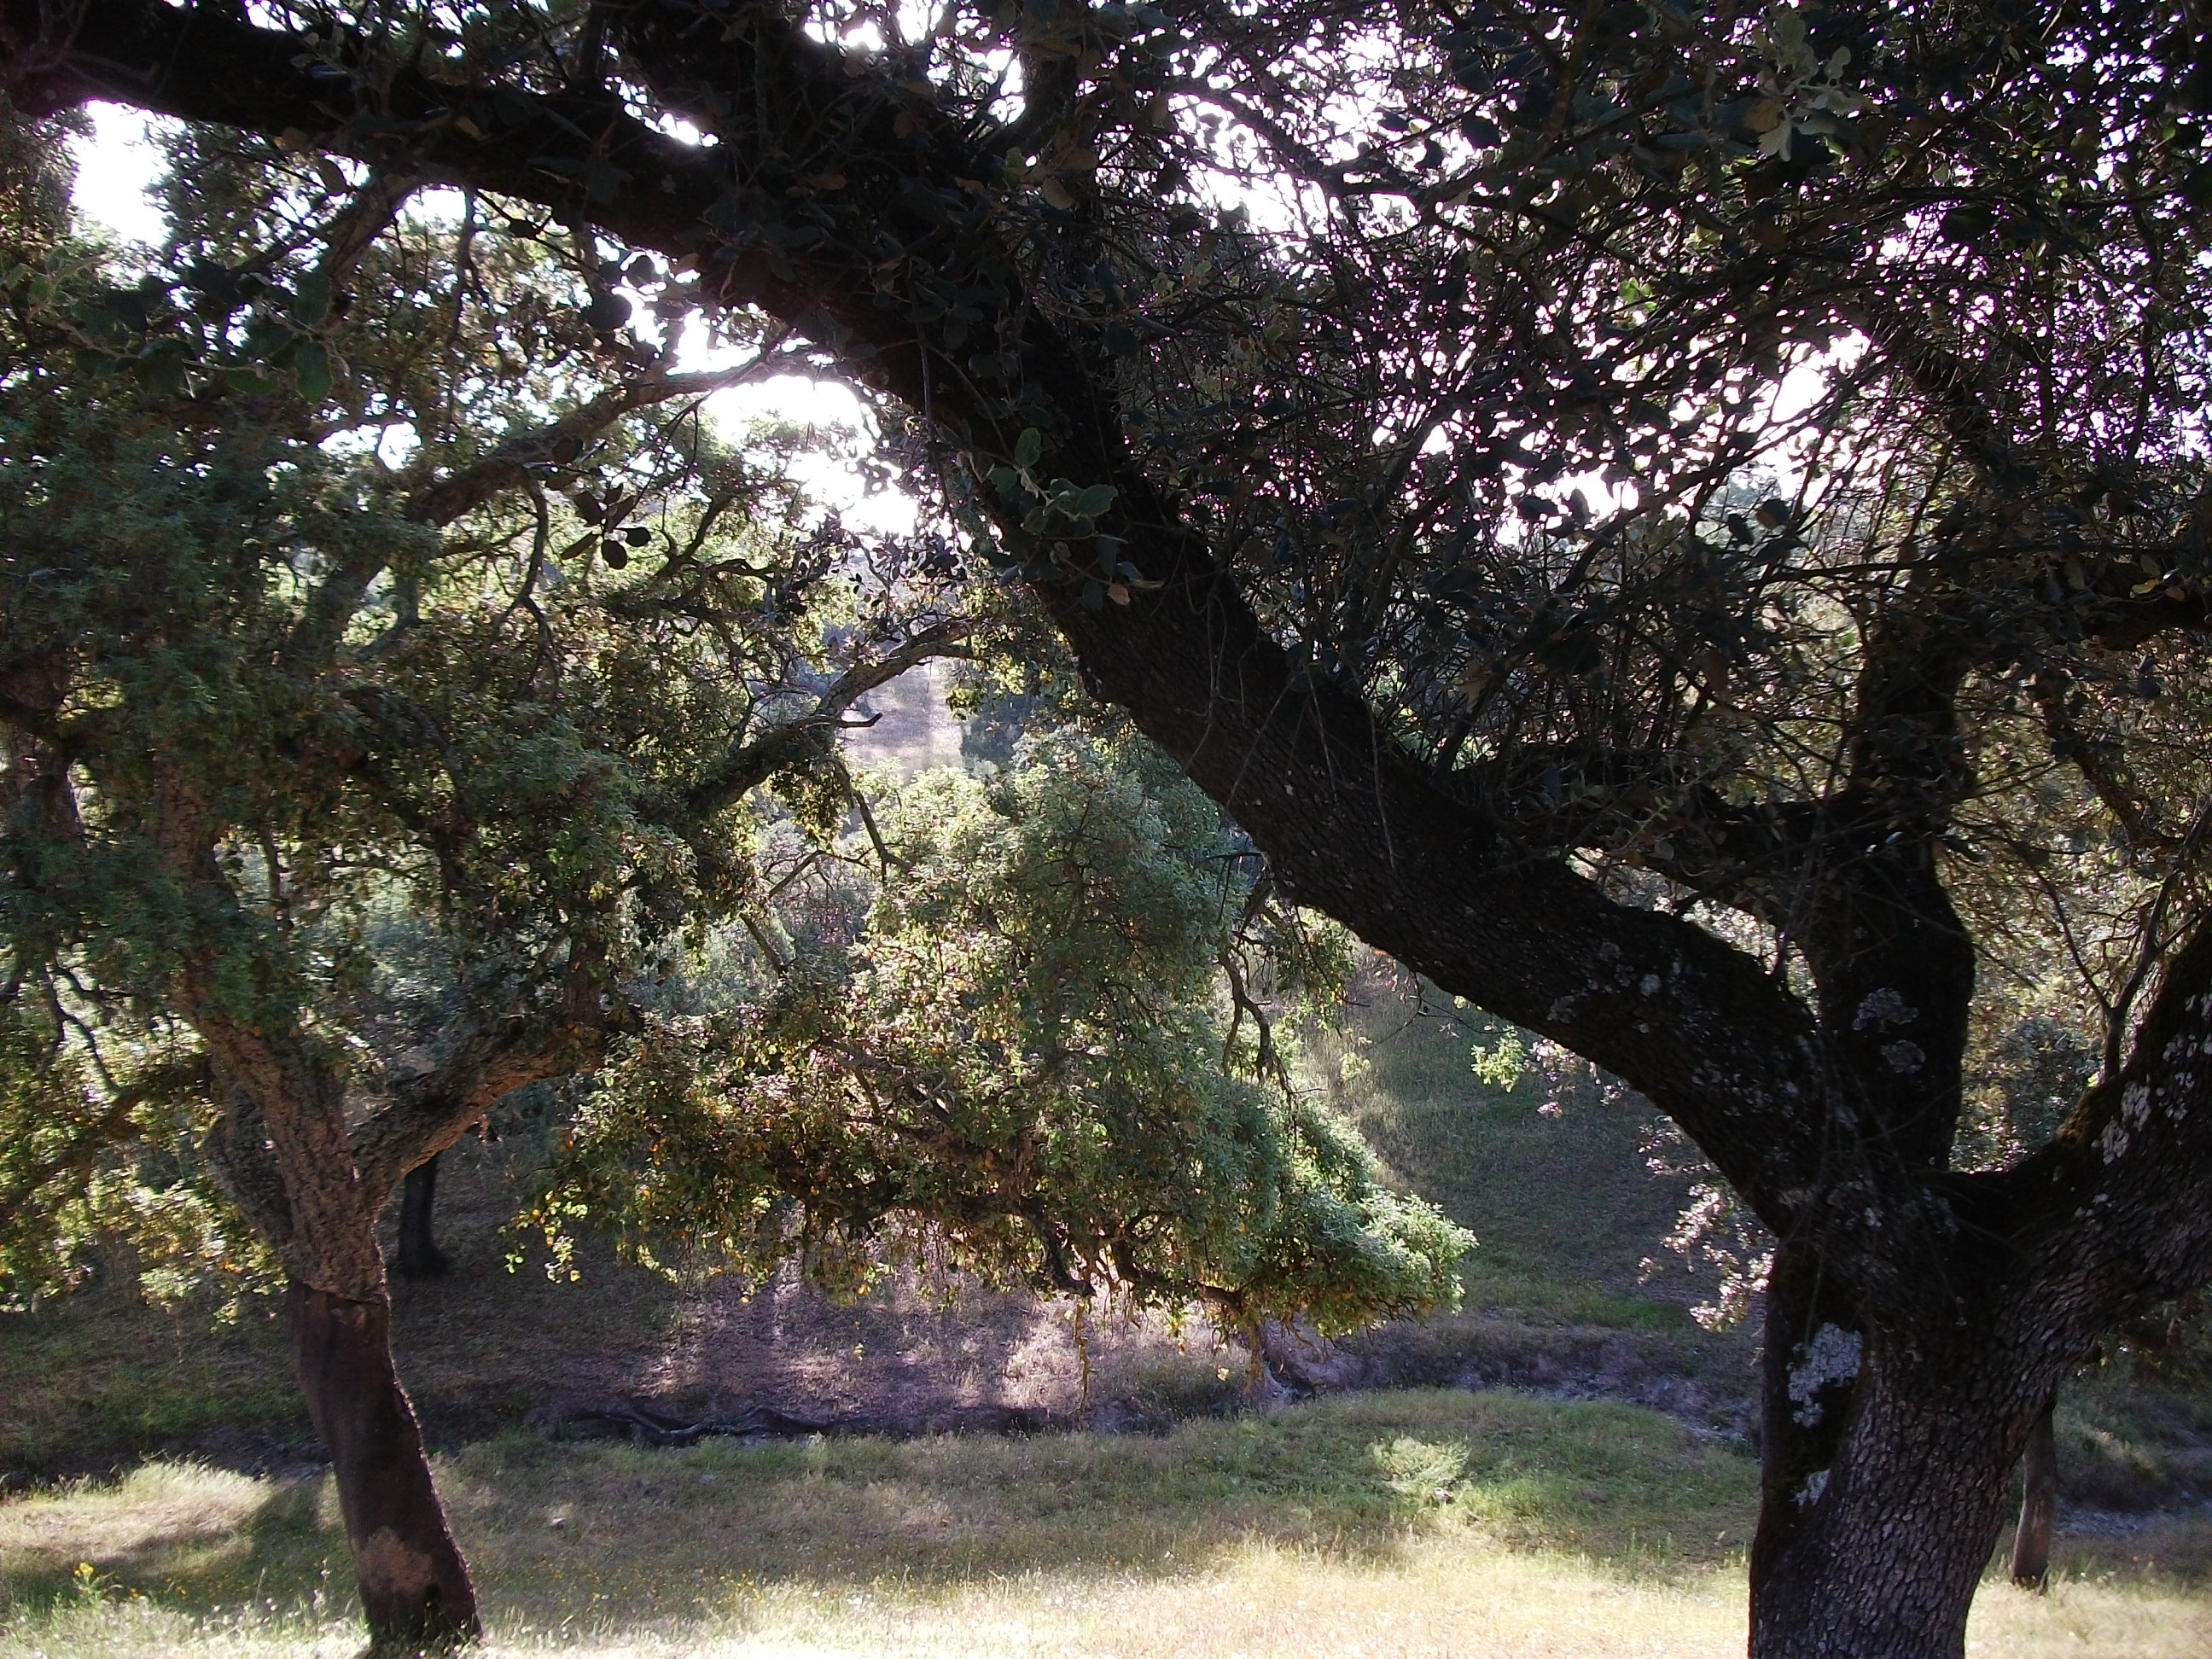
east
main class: Woodland
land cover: Broadleaved woodland
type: broadleaved evergreen forest
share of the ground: 25 - 50 %
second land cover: Spontaneously vegetated surfaces
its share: 25 - 50 %
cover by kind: herbaceous plants 55 %, broadleaved forest trees 45 %
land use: Forestry
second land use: Agriculture (excluding fallow land and kitchen gardens)
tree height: > 5 m
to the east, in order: Broadleaved woodland; Spontaneously vegetated surfaces; Rivers and streams; Broadleaved woodland; Rivers and streams; Broadleaved woodland; Fences; Grass margins; Rock outcrops; Tracks; Broadleaved woodland; Inland fresh water bodies
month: May
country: ES
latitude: 37.9800
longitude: -7.1918
